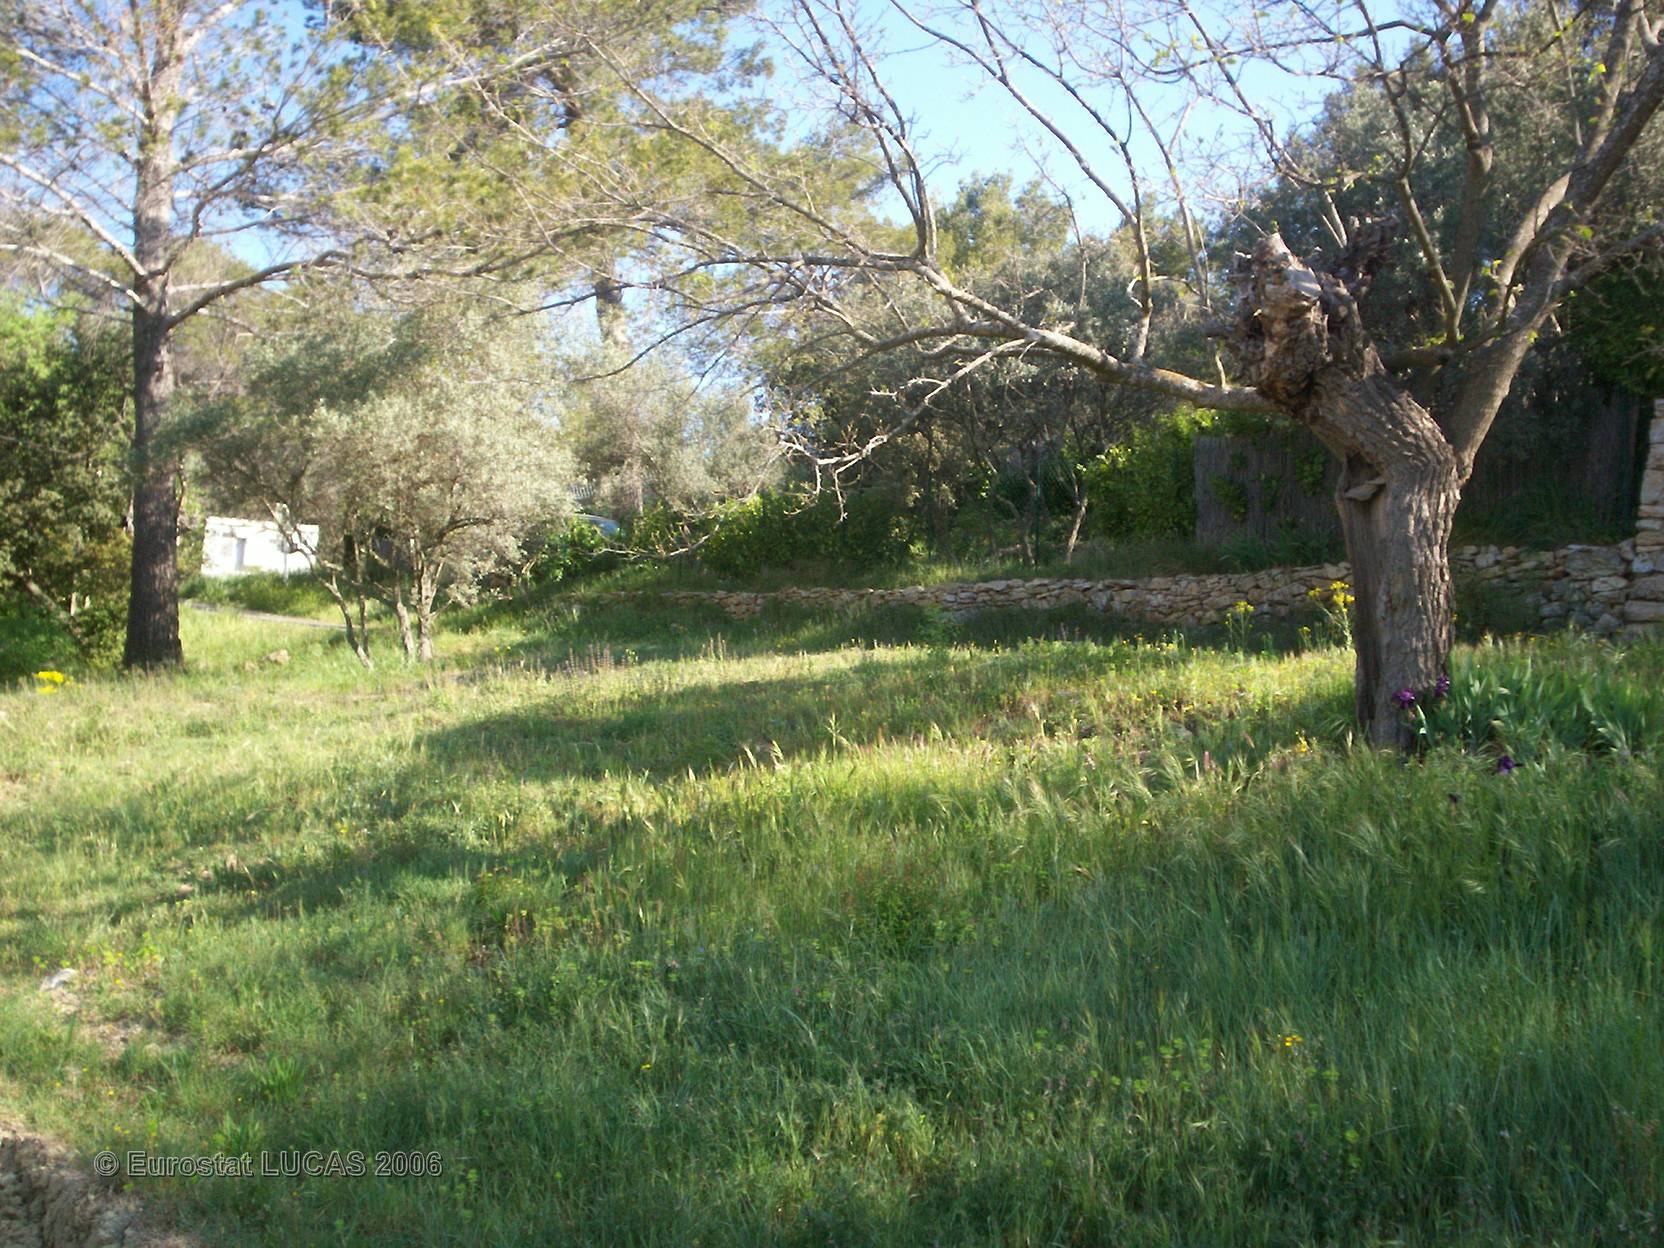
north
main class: Cropland
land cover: Other leguminous and mixtures for fodder
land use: Agriculture (excluding fallow land and kitchen gardens)
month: April
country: FR
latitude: 43.5502
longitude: 5.5412
